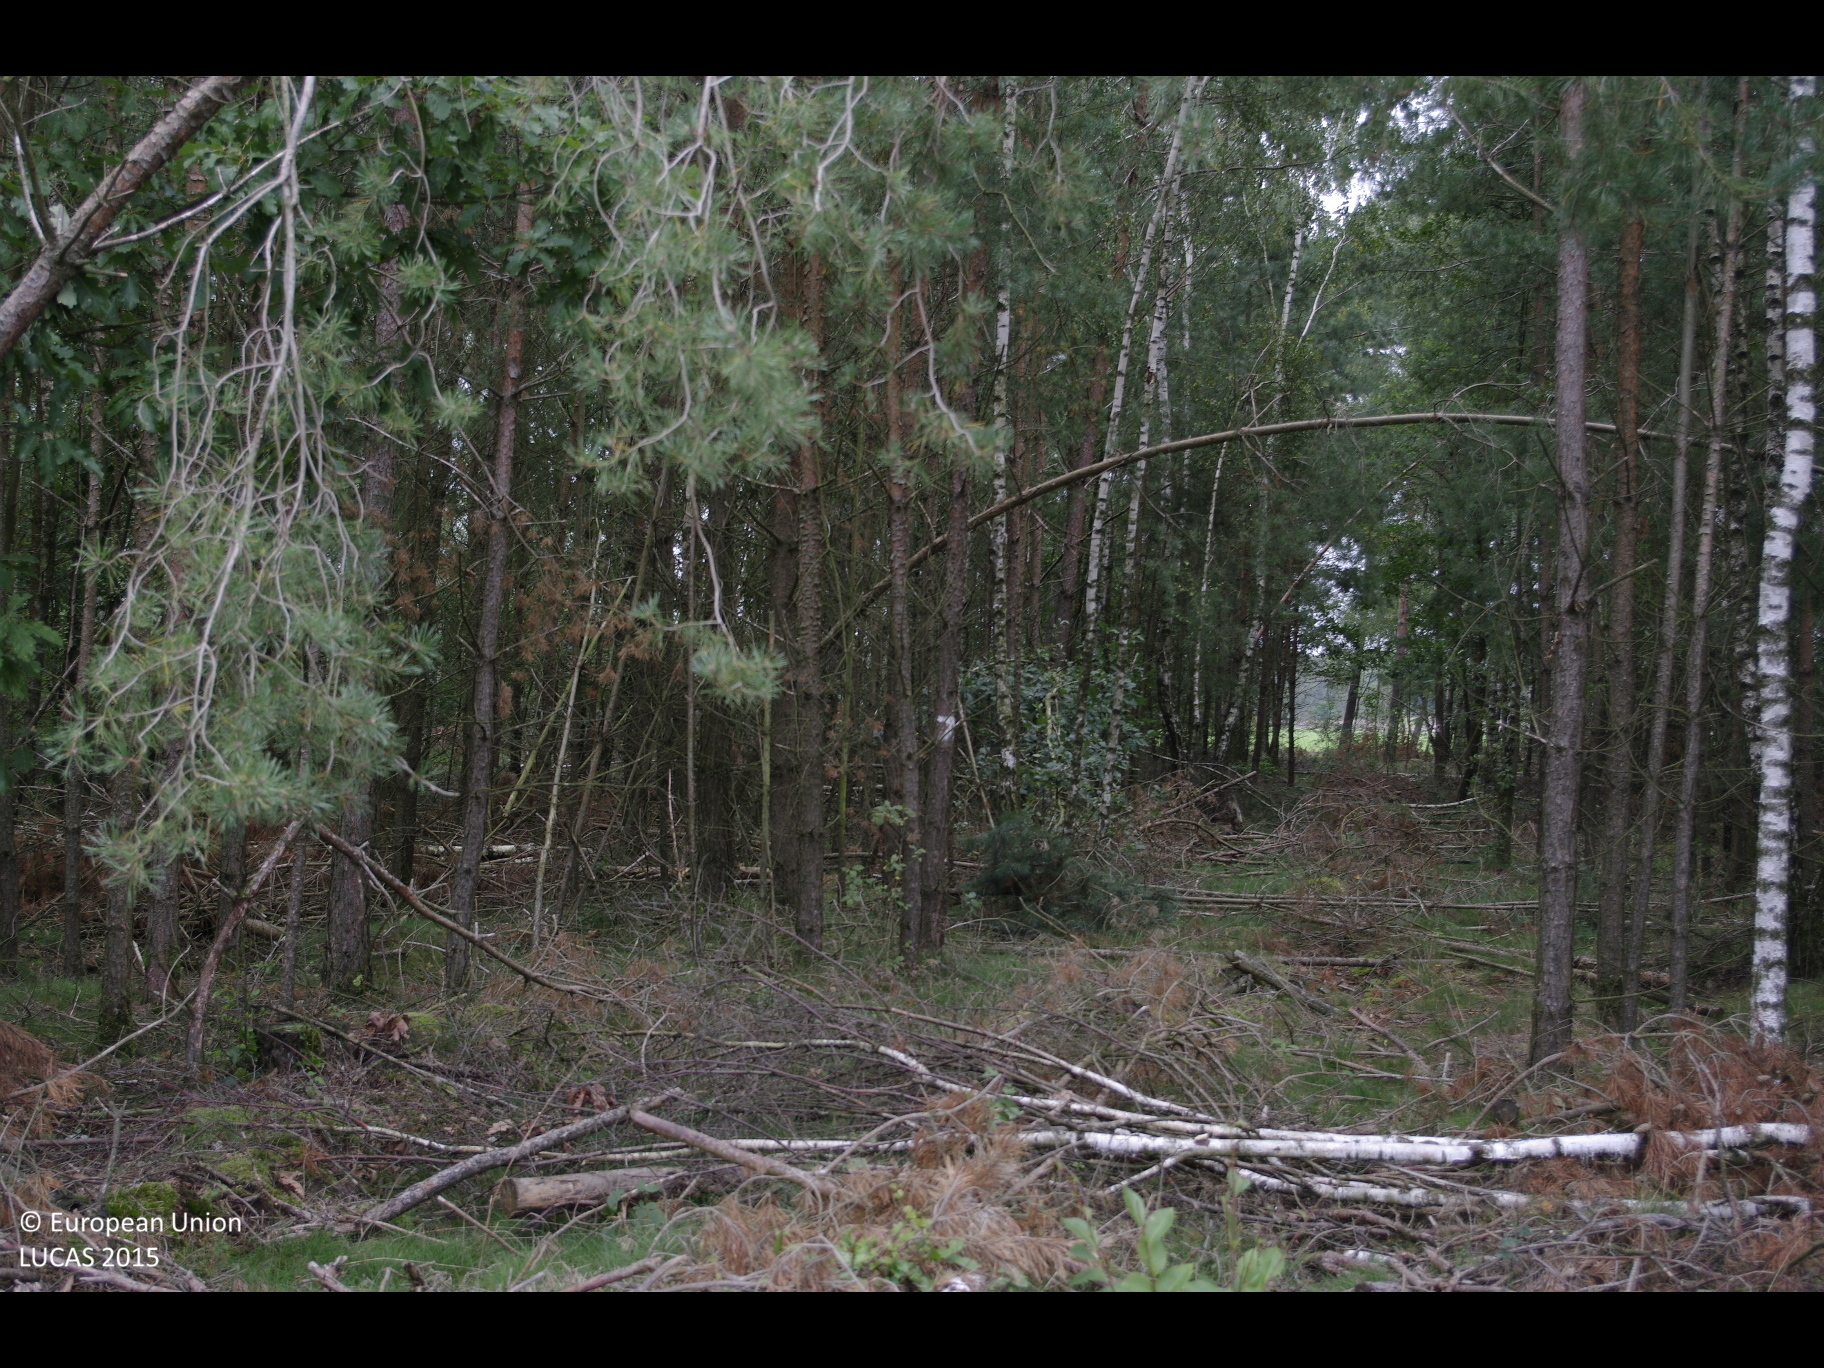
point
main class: Woodland
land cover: Pine dominated mixed woodland
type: hemiboreal forest and nemoral coniferous forest and mixed broadleaved-coniferous forest
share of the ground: > 75 %
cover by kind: coniferous forest trees 50 %, broadleaved forest trees 40 %, herbaceous plants 10 %
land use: Forestry
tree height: > 5 m
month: September
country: DE
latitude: 53.0963
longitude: 9.8657
